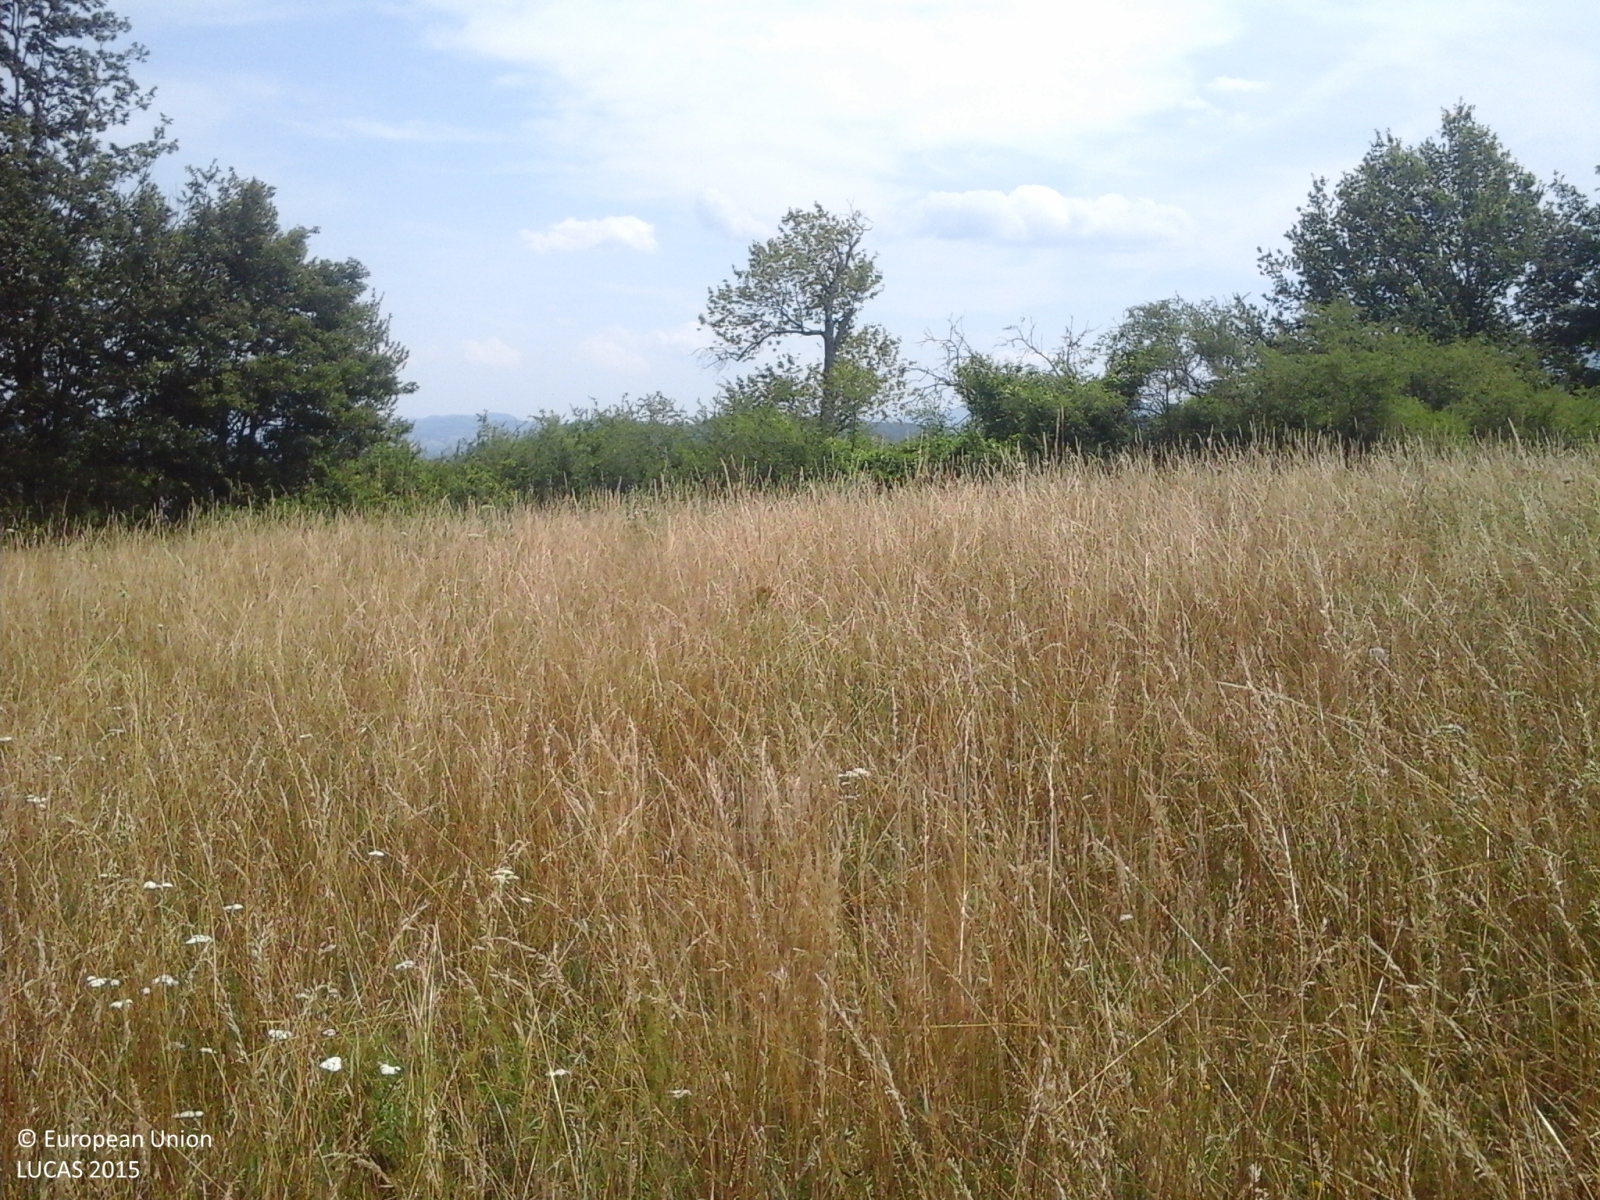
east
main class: Grassland
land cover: Grassland without tree/shrub cover
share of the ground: > 75 %
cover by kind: herbaceous plants 100 %
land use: Agriculture (excluding fallow land and kitchen gardens)
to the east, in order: Grassland without tree/shrub cover; Managed hedges; Grassland without tree/shrub cover; Broadleaved woodland
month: July
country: IT
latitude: 44.3861
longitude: 10.3381
